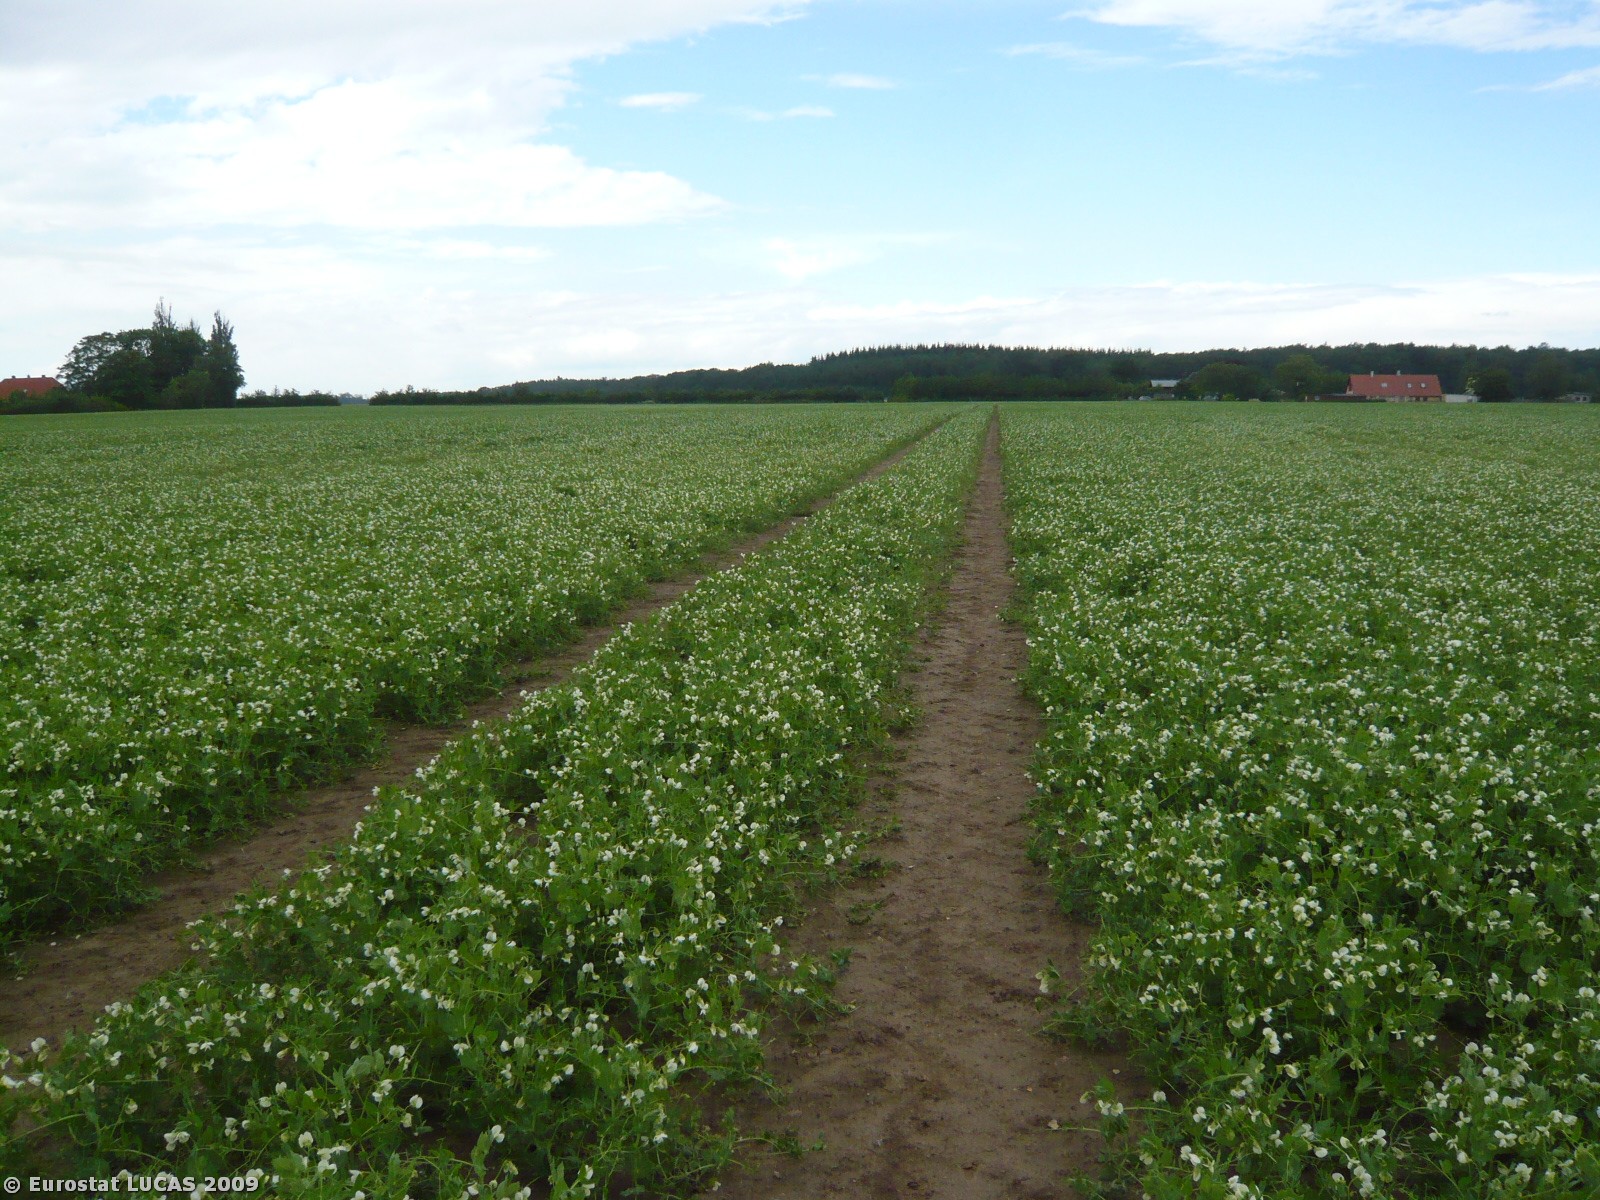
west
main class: Cropland
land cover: Dry pulses
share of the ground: > 75 %
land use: Agriculture (excluding fallow land and kitchen gardens)
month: June
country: DK
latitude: 54.8122
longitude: 11.5394
